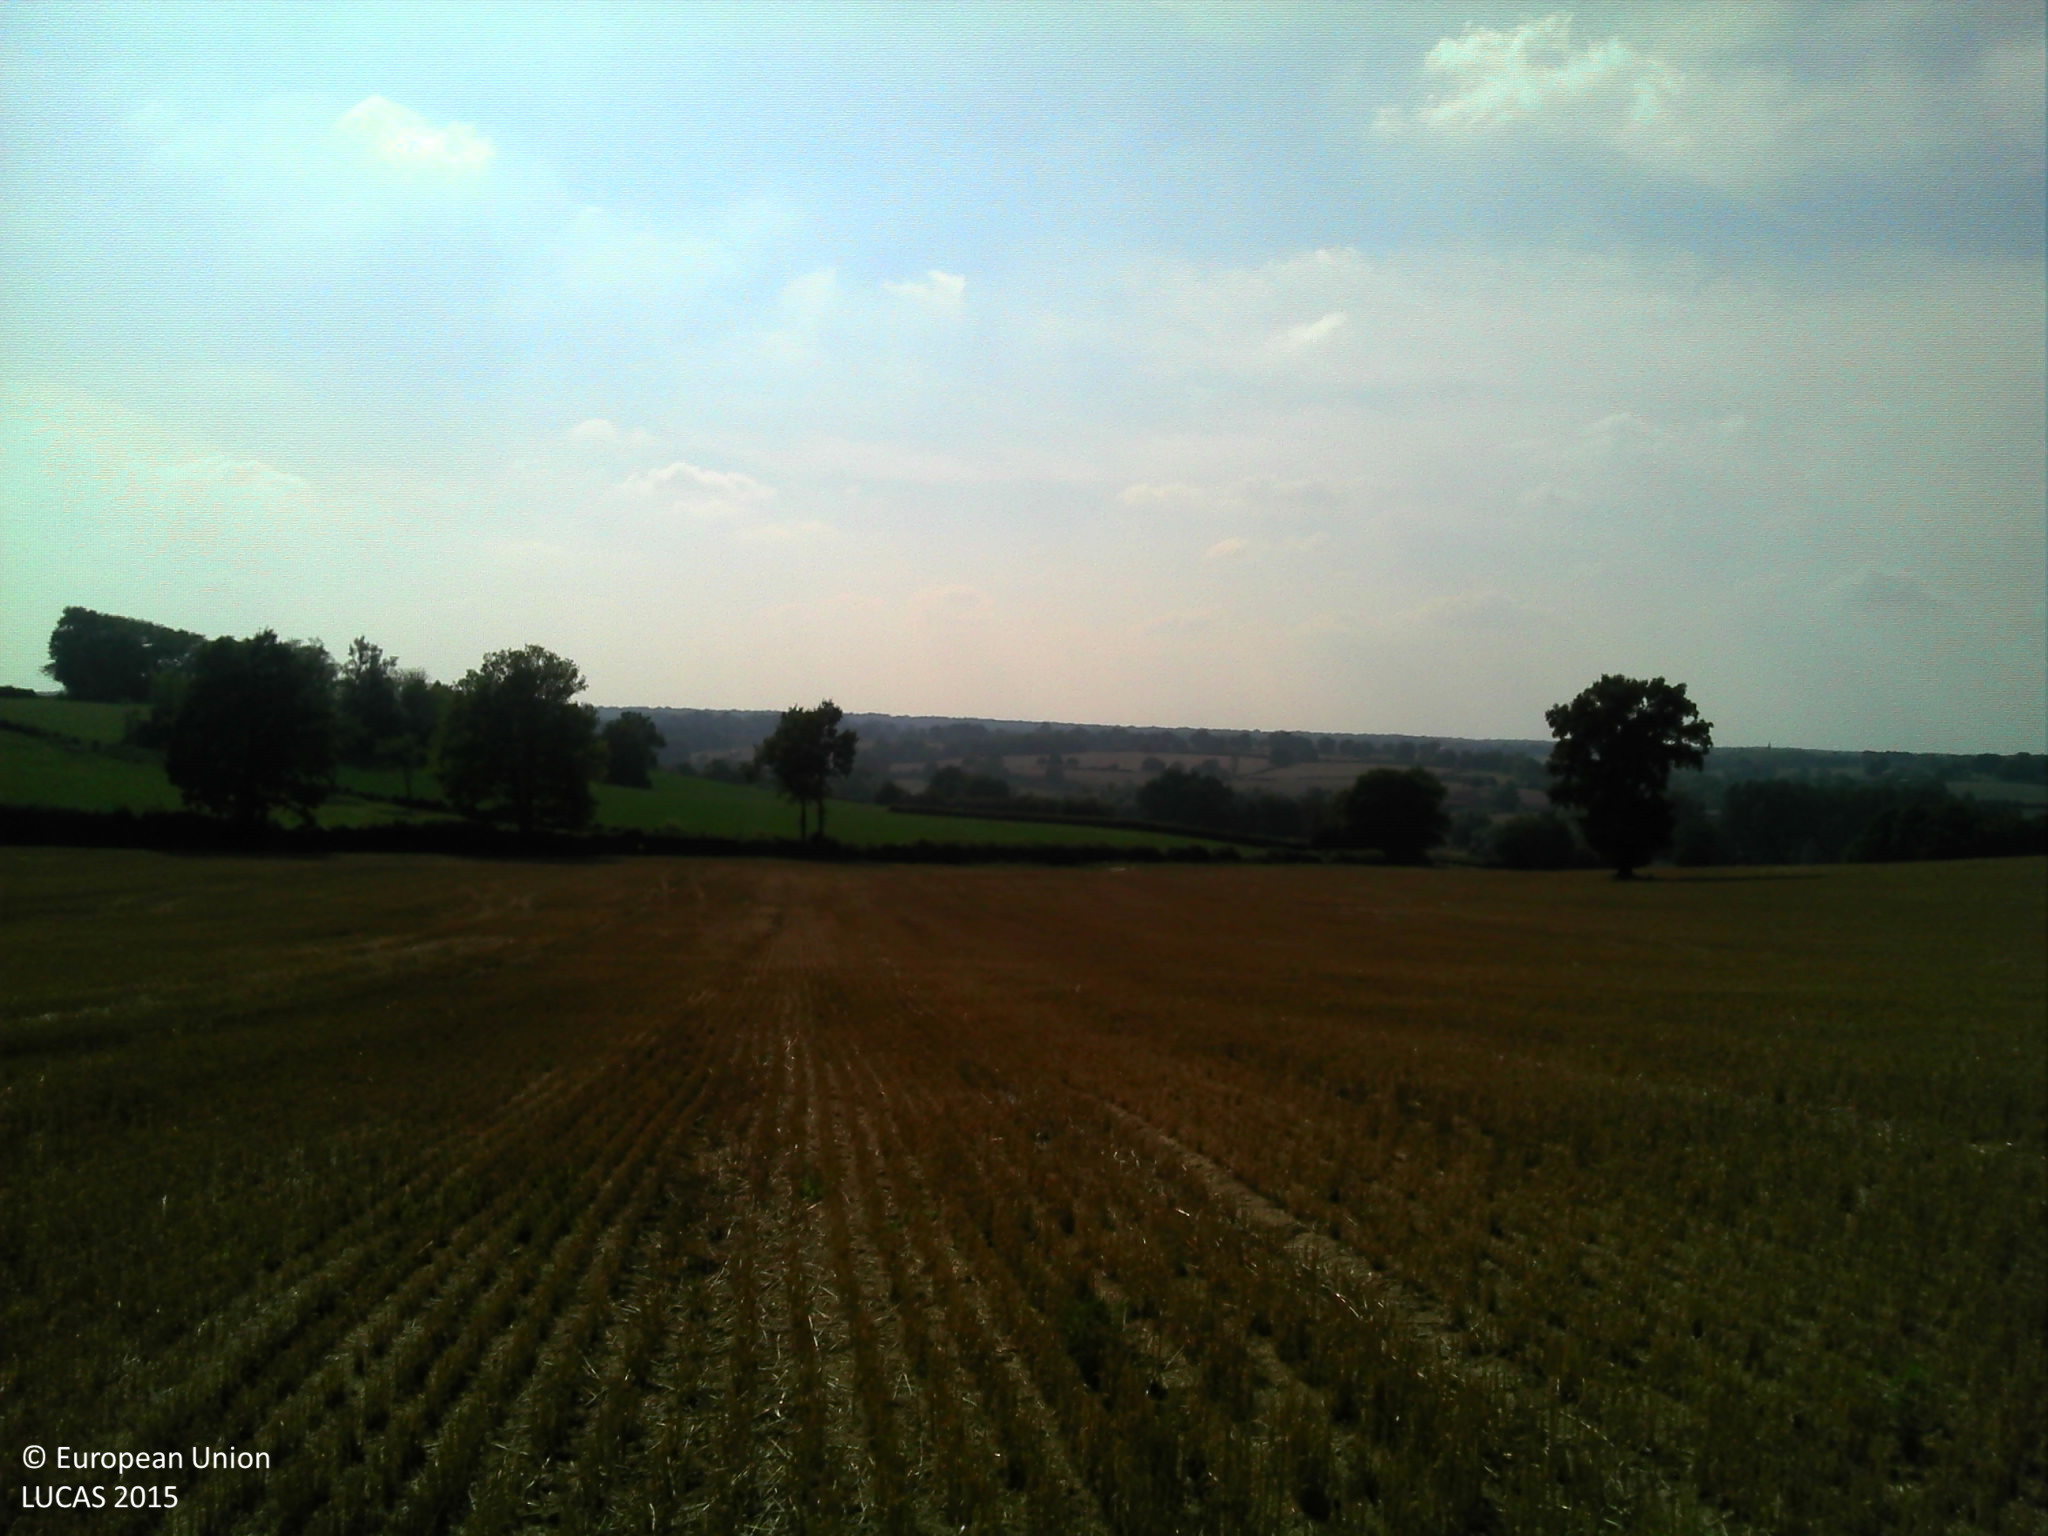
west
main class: Cropland
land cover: Common wheat
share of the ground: > 75 %
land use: Agriculture (excluding fallow land and kitchen gardens)
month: August
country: FR
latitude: 46.3952
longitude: 3.6139
